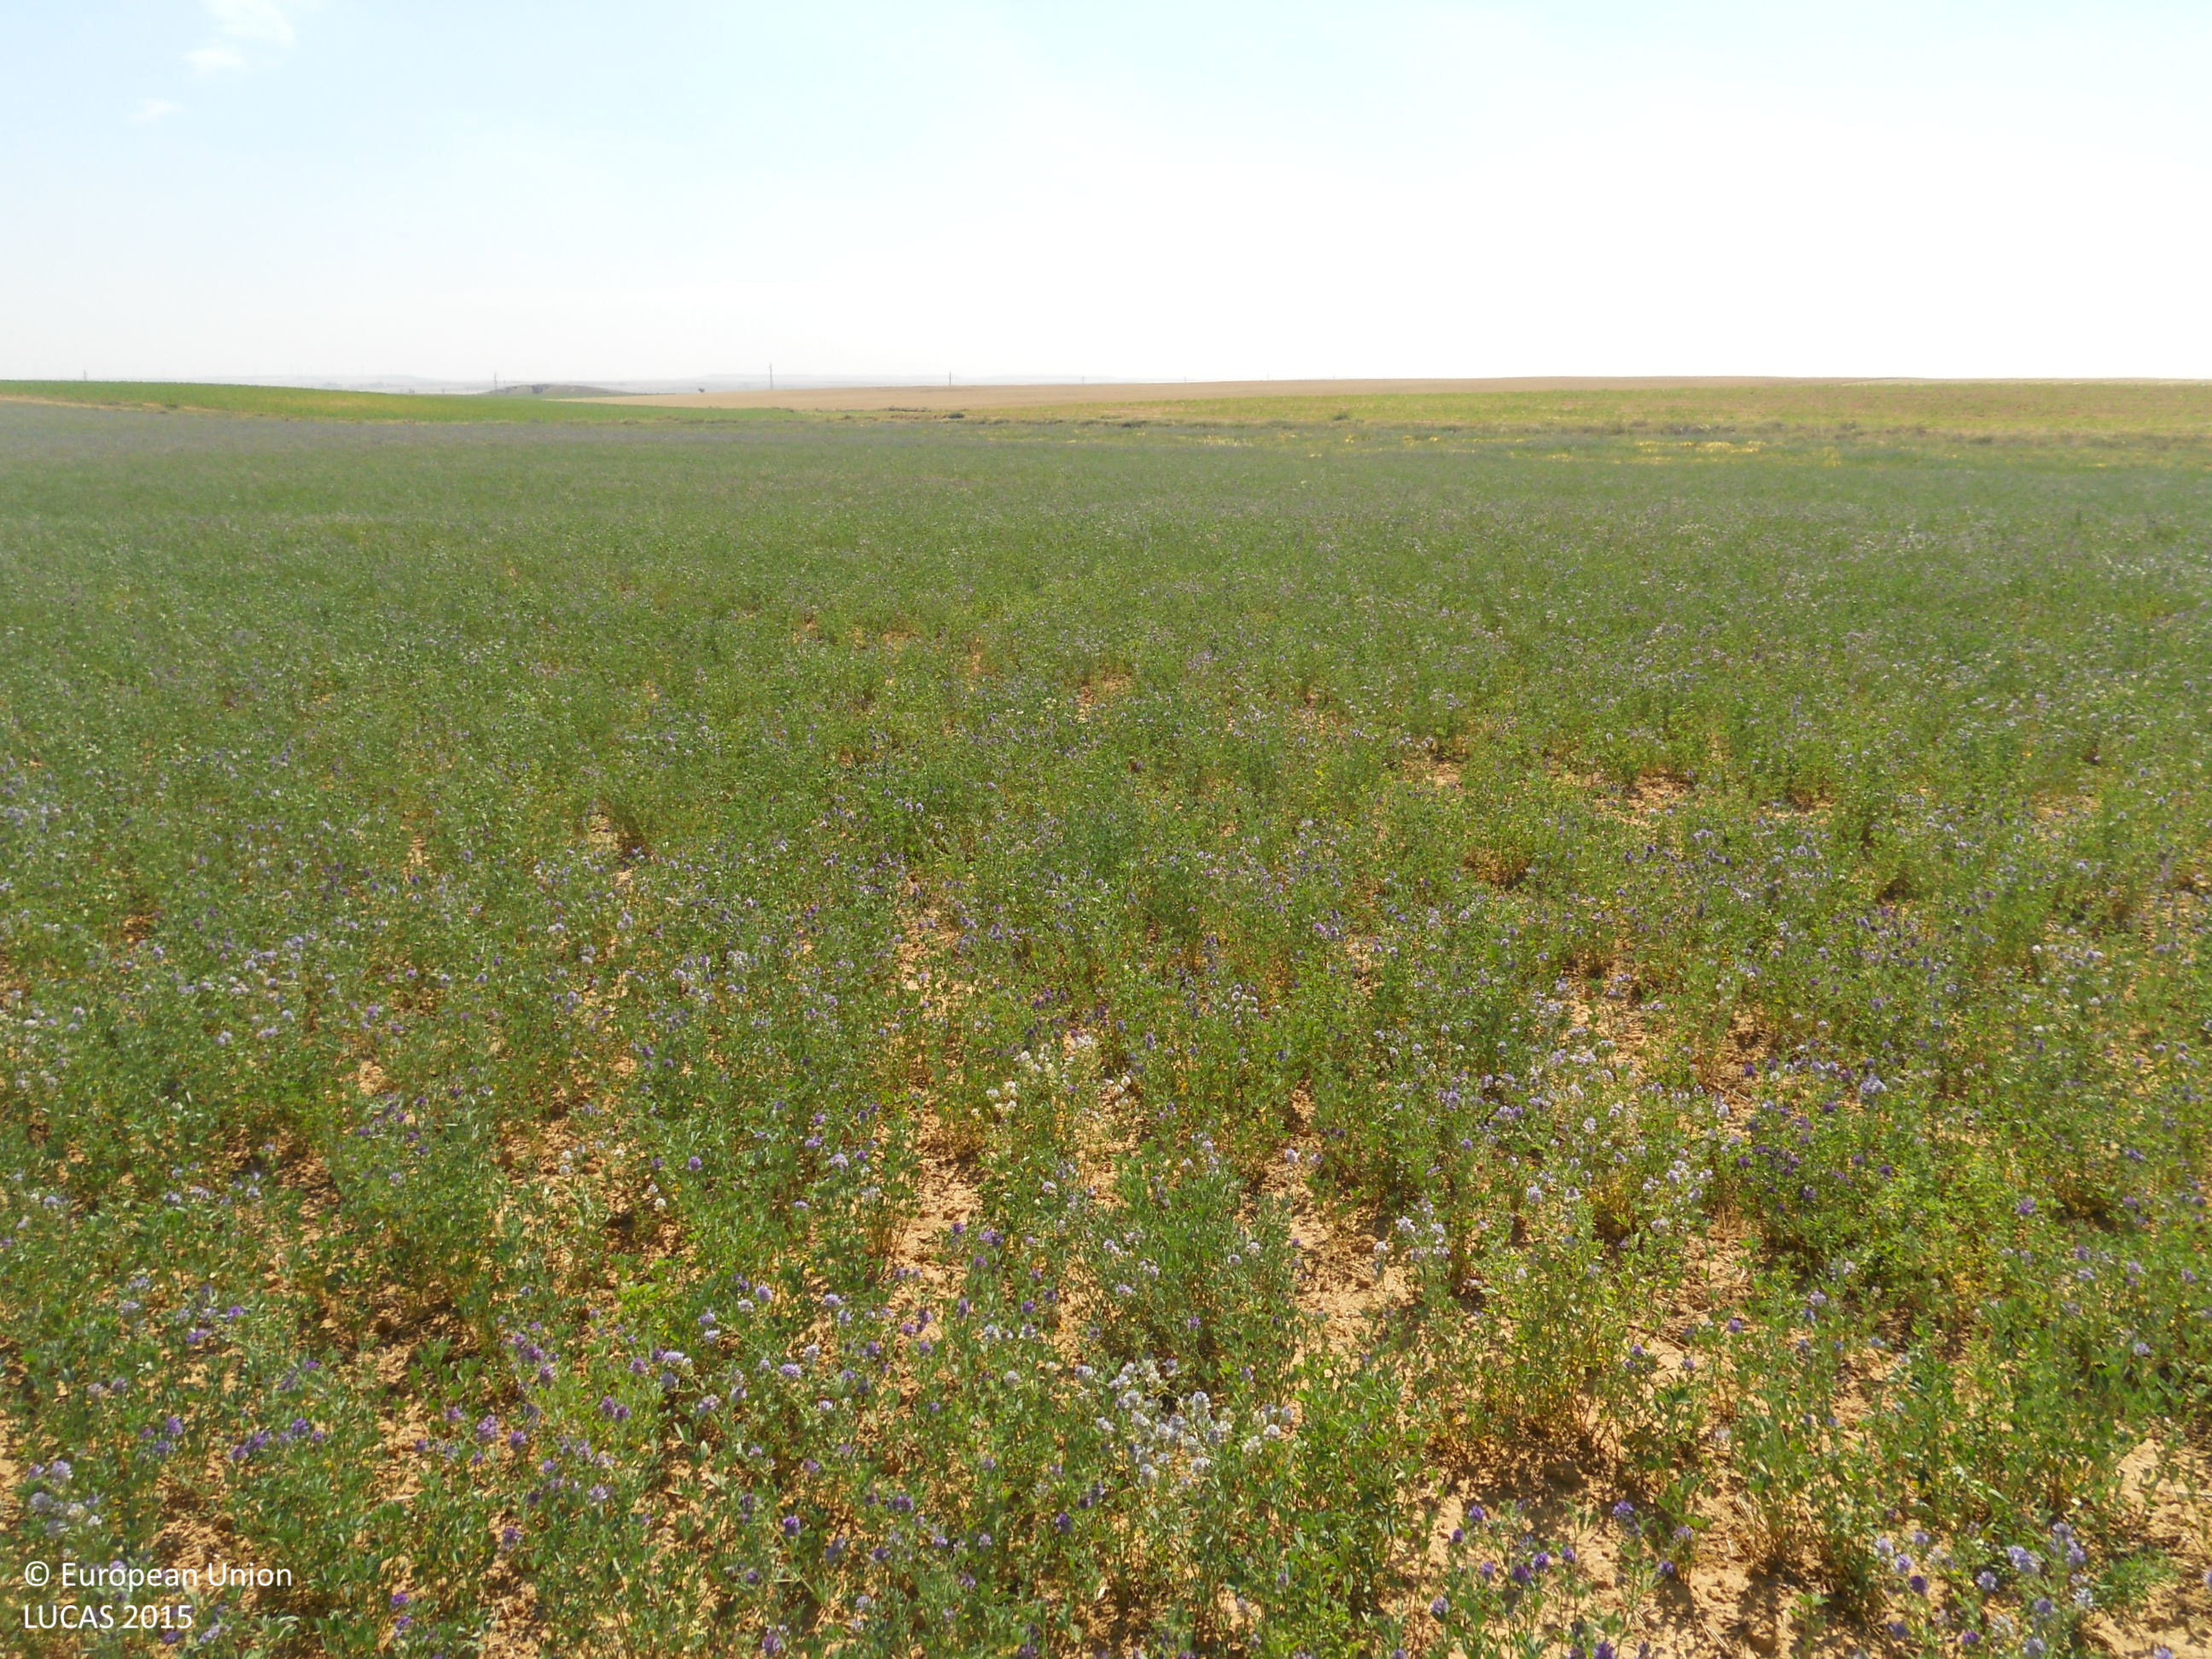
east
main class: Cropland
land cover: Lucerne
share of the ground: > 75 %
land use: Agriculture (excluding fallow land and kitchen gardens)
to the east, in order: Lucerne; Grass margins; Tracks; Grass margins; Sunflower
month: July
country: ES
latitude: 42.2025
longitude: -4.9157
